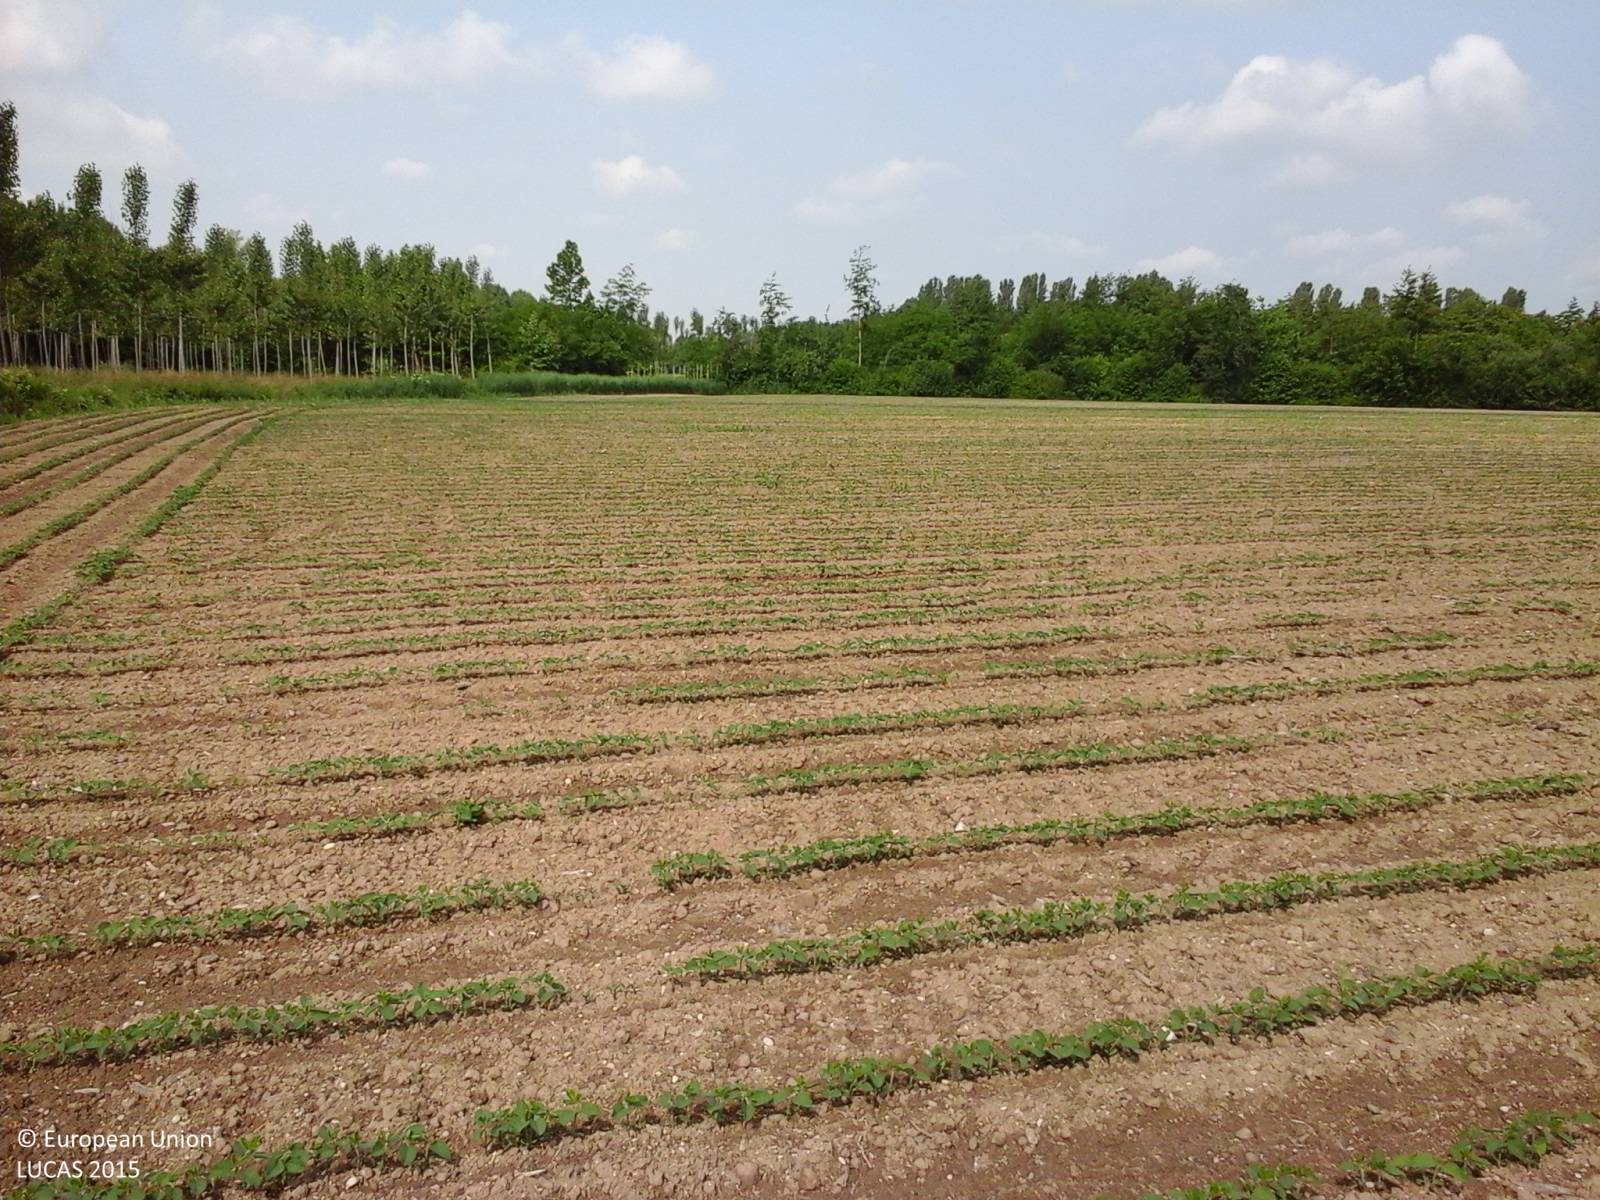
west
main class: Cropland
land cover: Soya
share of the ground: < 10 %
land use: Agriculture (excluding fallow land and kitchen gardens)
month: May
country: IT
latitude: 45.8526
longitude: 13.2028
